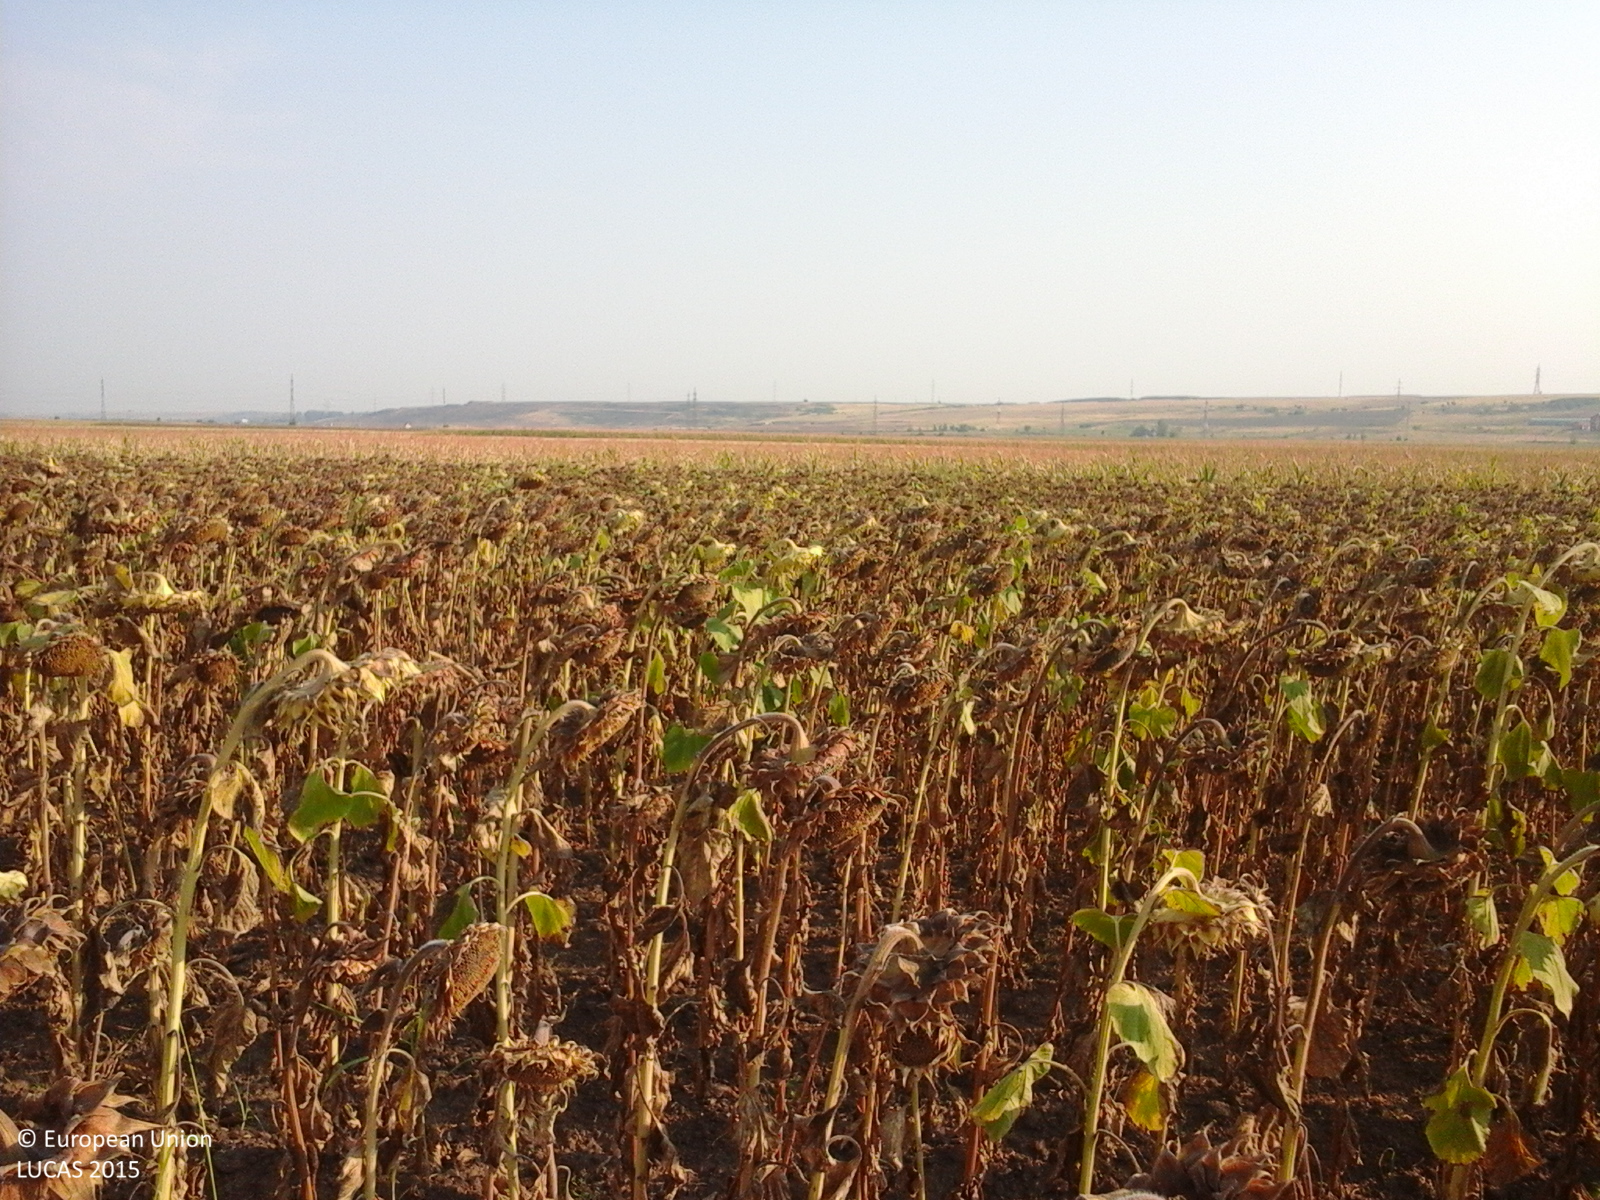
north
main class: Cropland
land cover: Sunflower
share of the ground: > 75 %
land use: Agriculture (excluding fallow land and kitchen gardens)
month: August
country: RO
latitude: 44.1338
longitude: 22.9787
